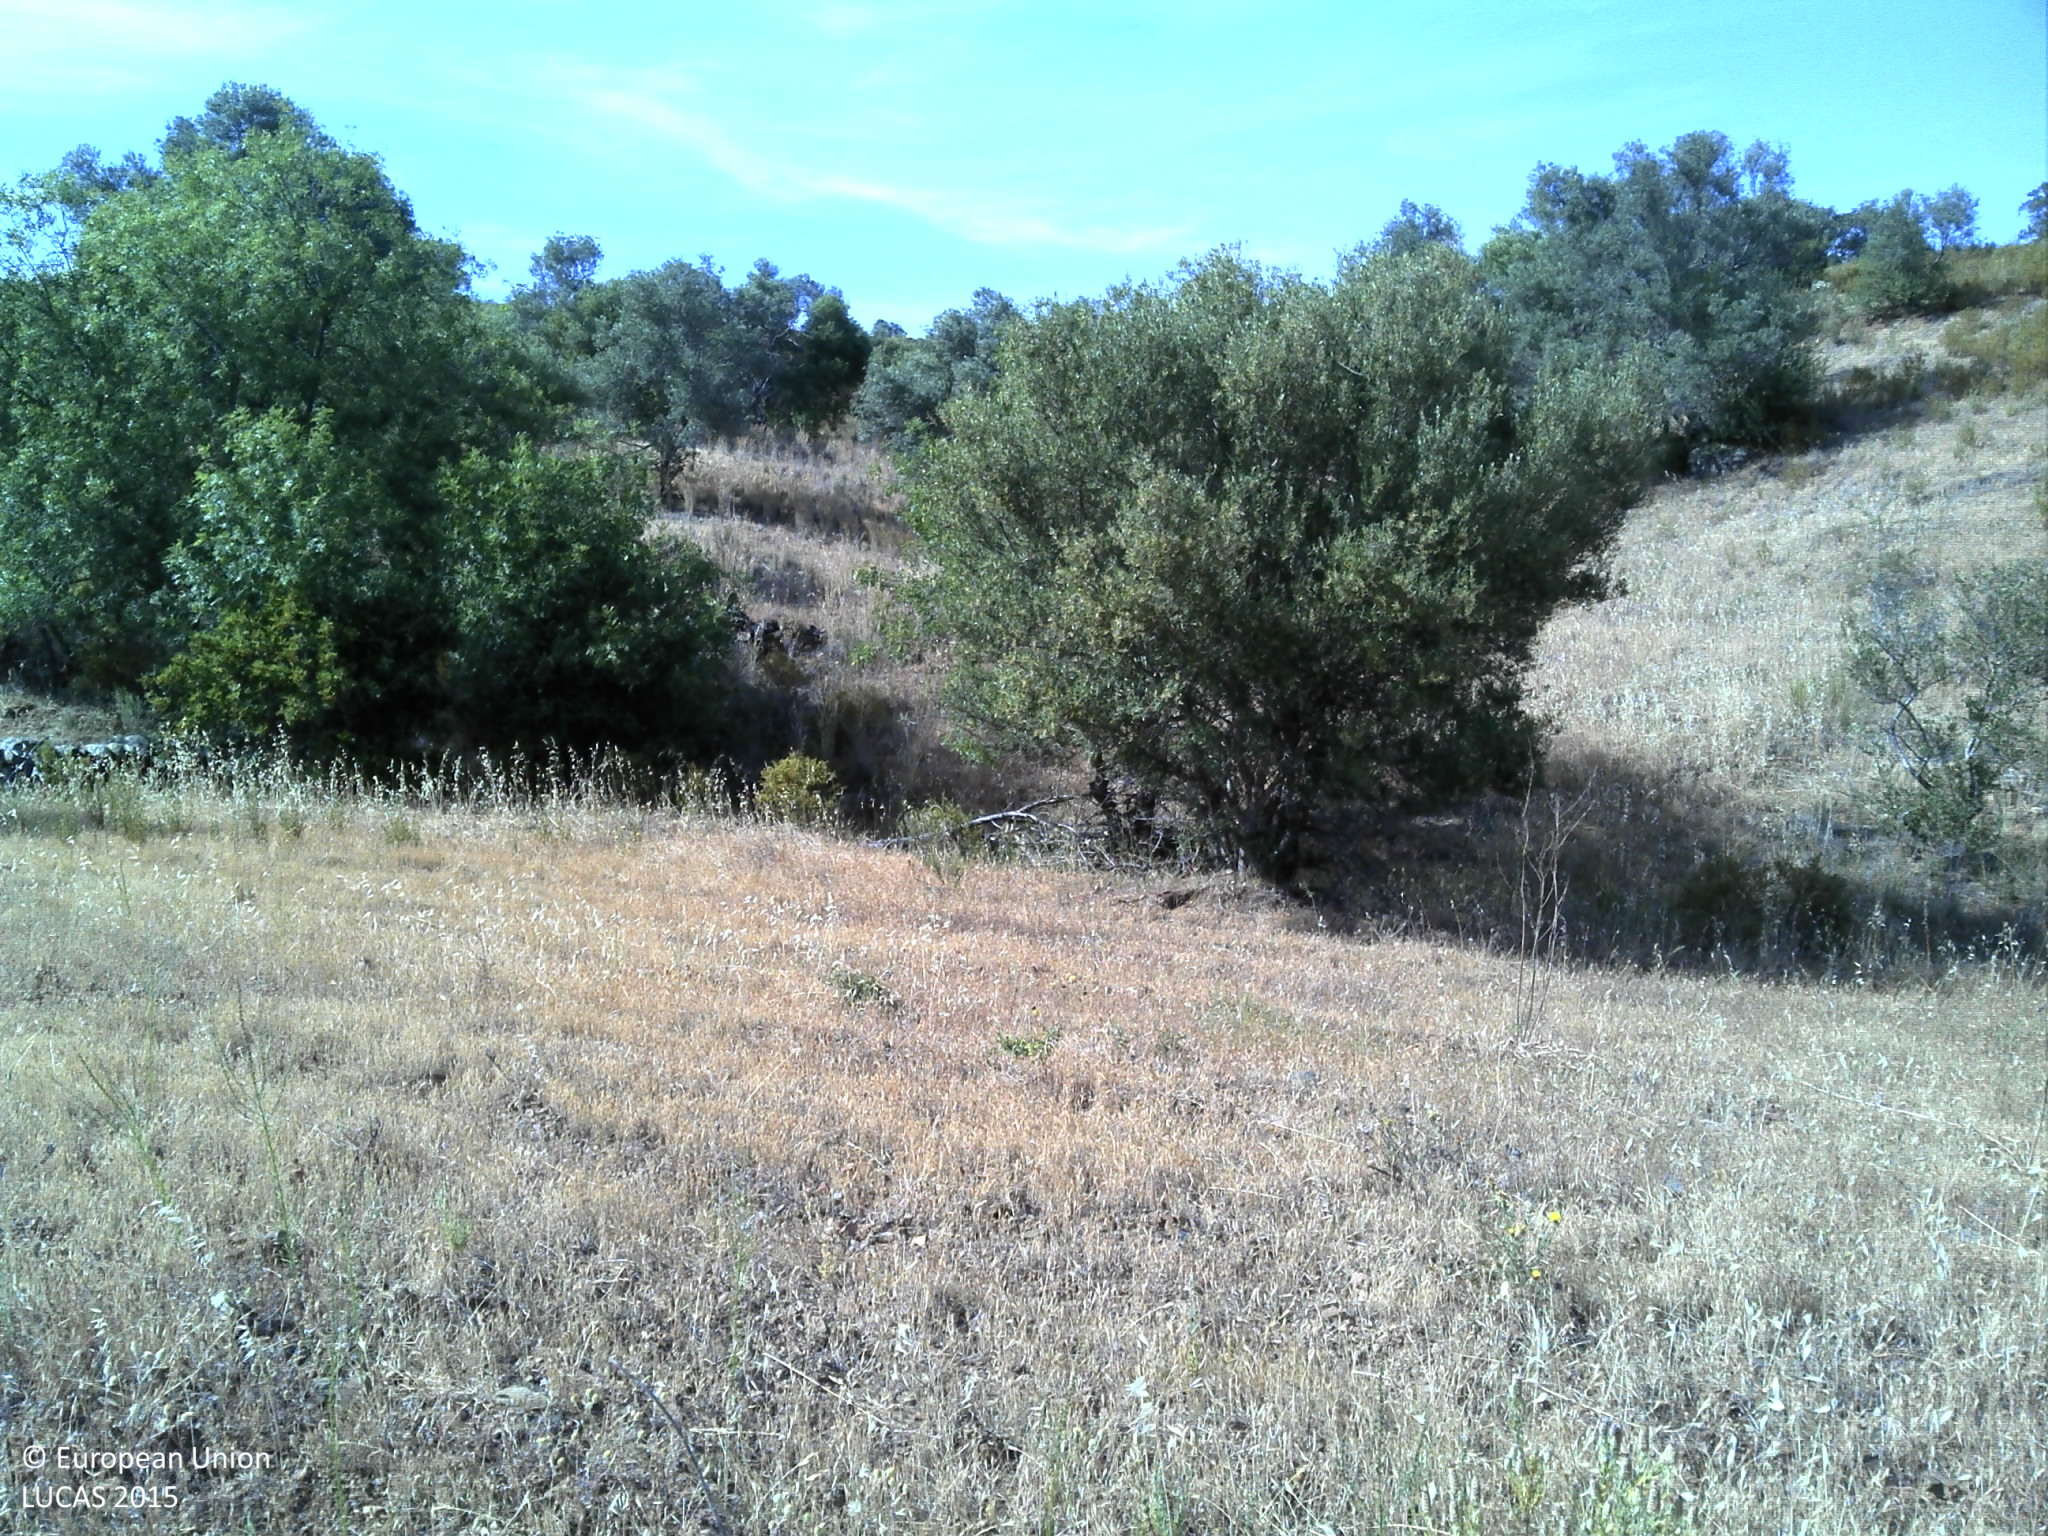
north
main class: Grassland
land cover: Grassland with sparse tree/shrub cover
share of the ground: 50 - 75 %
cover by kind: herbaceous plants 70 %, unconsolidated bare surface 25 %, broadleaved forest trees 5 %
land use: Agriculture (excluding fallow land and kitchen gardens)
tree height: > 5 m
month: May
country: PT
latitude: 37.2852
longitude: -7.4529
